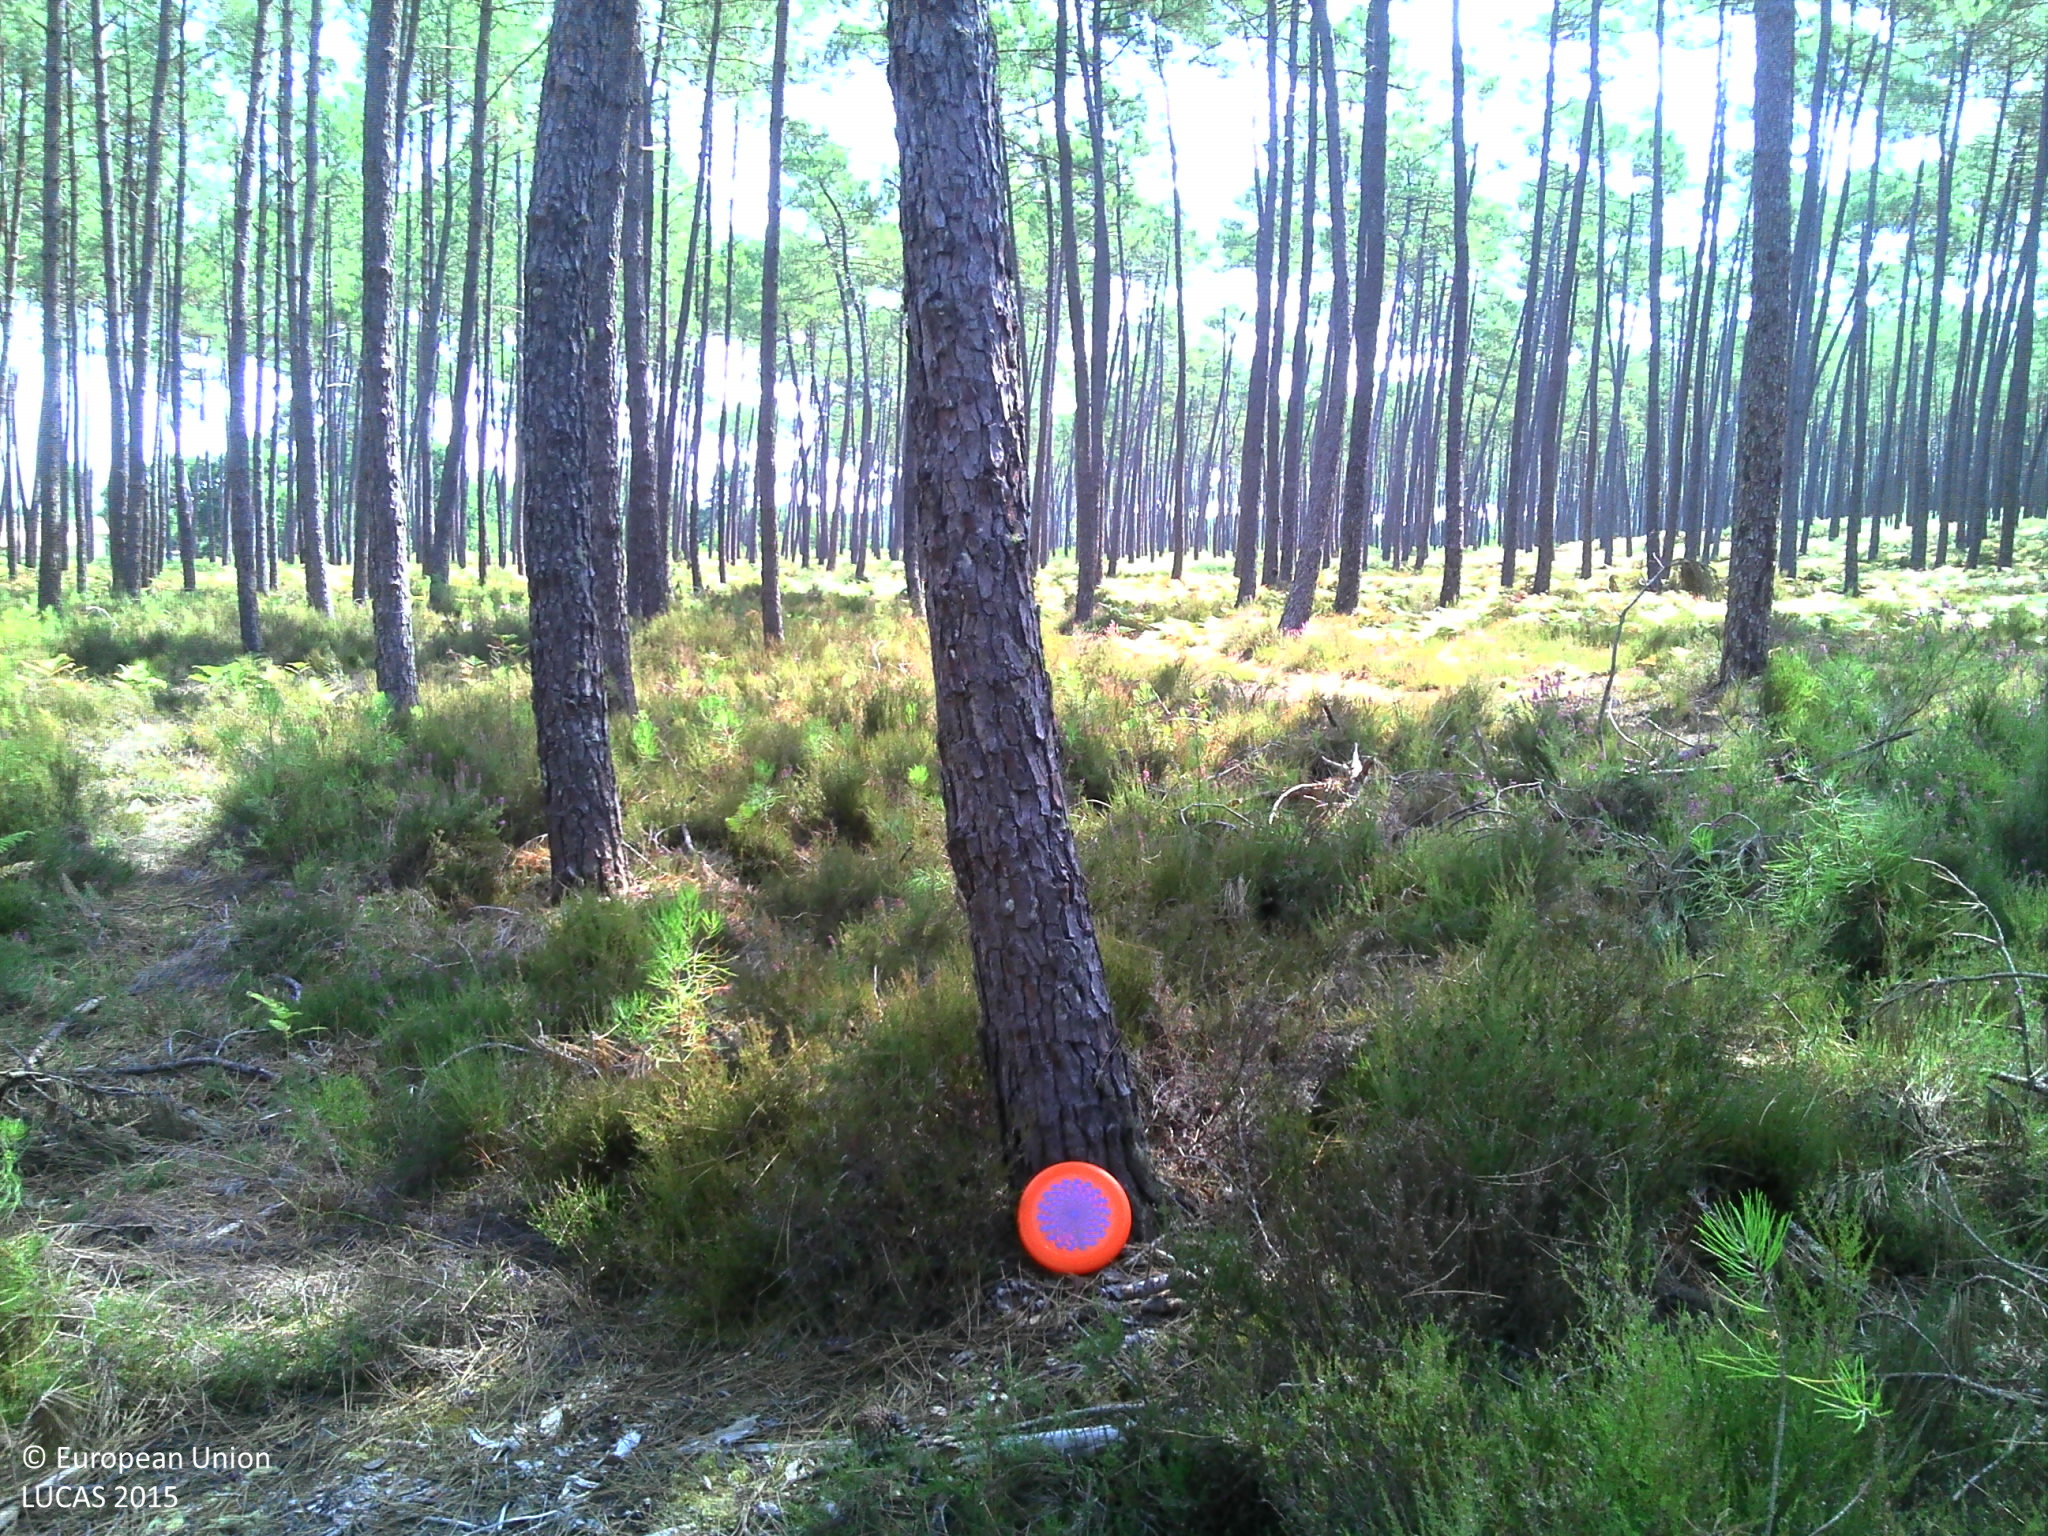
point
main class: Woodland
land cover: Pine dominated coniferous woodland
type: coniferous forest of the mediterranean region
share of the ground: > 75 %
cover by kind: coniferous forest trees 85 %, herbaceous plants 10 %, shrubs 5 %
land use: Forestry
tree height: > 5 m
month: August
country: FR
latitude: 44.1933
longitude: -1.0669
